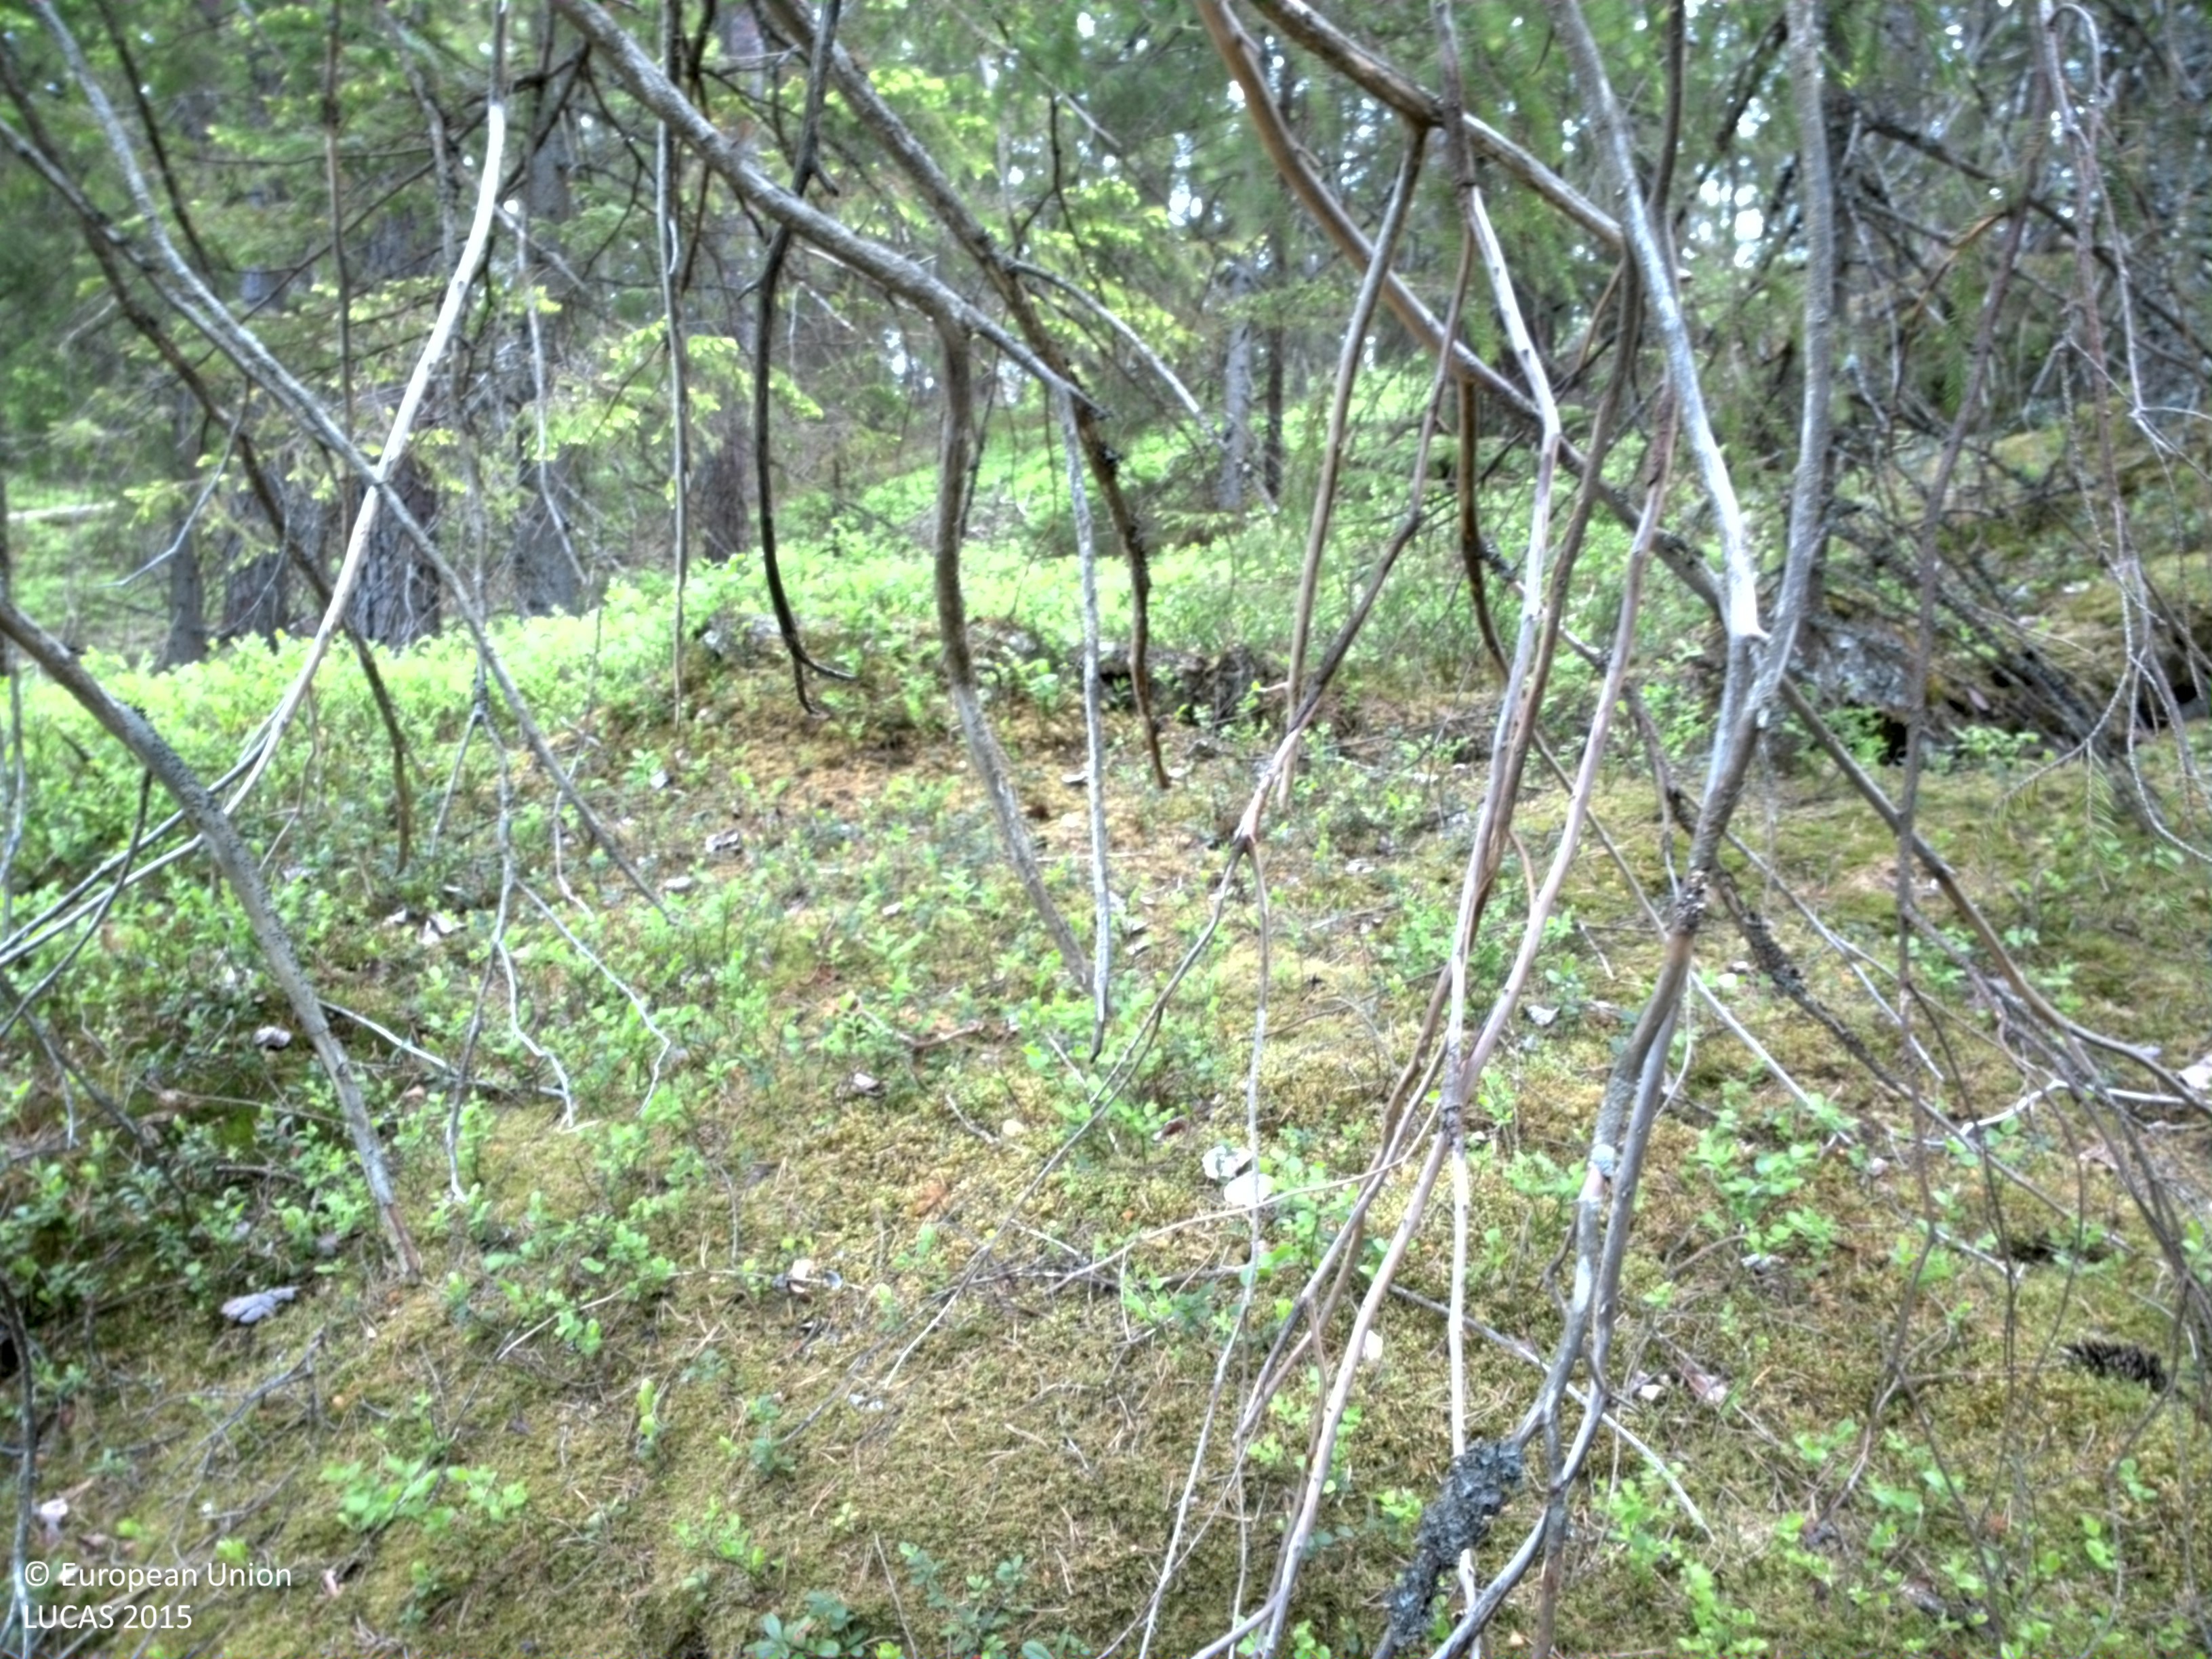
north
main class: Woodland
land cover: Spruce dominated coniferous woodland
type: boreal forest
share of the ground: 25 - 50 %
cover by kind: coniferous forest trees 45 %, shrubs 45 %, broadleaved forest trees 5 %, lichens and mosses 5 %
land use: Forestry
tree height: > 5 m
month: June
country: SE
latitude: 57.4982
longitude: 13.8500
